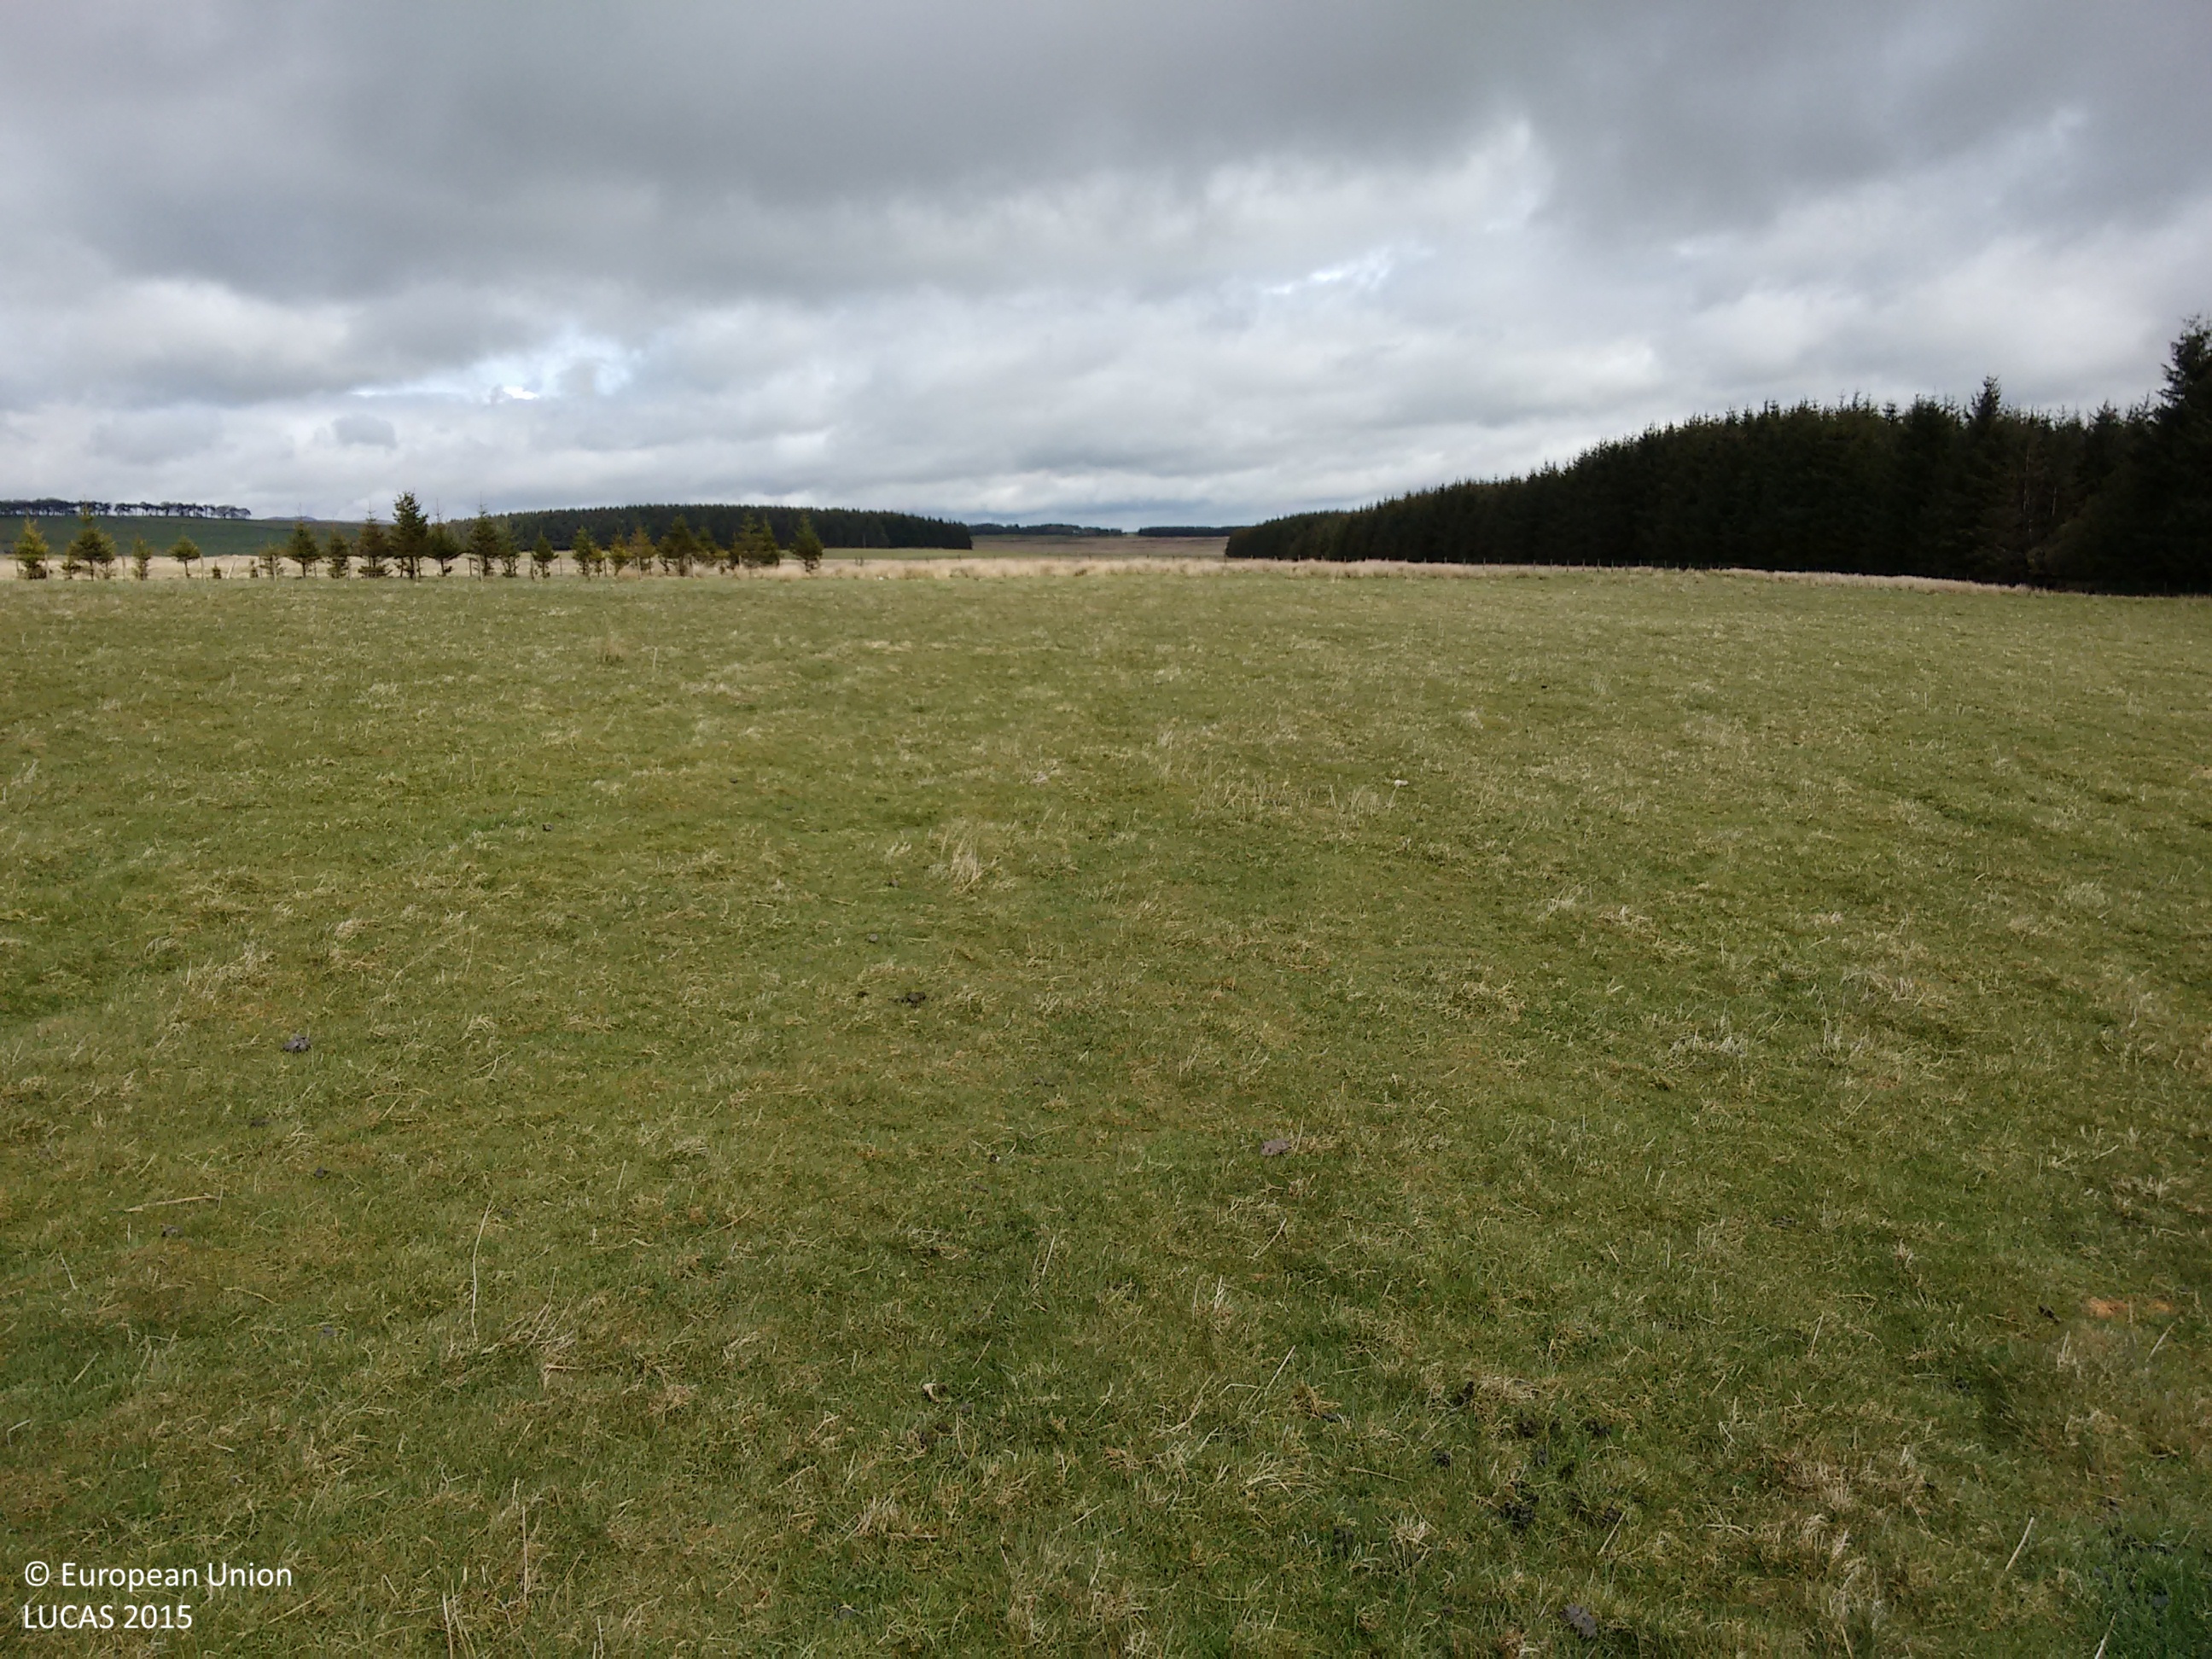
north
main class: Grassland
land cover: Grassland without tree/shrub cover
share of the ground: > 75 %
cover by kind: herbaceous plants 100 %
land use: Agriculture (excluding fallow land and kitchen gardens)
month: May
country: GB
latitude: 55.7763
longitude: -3.1930
